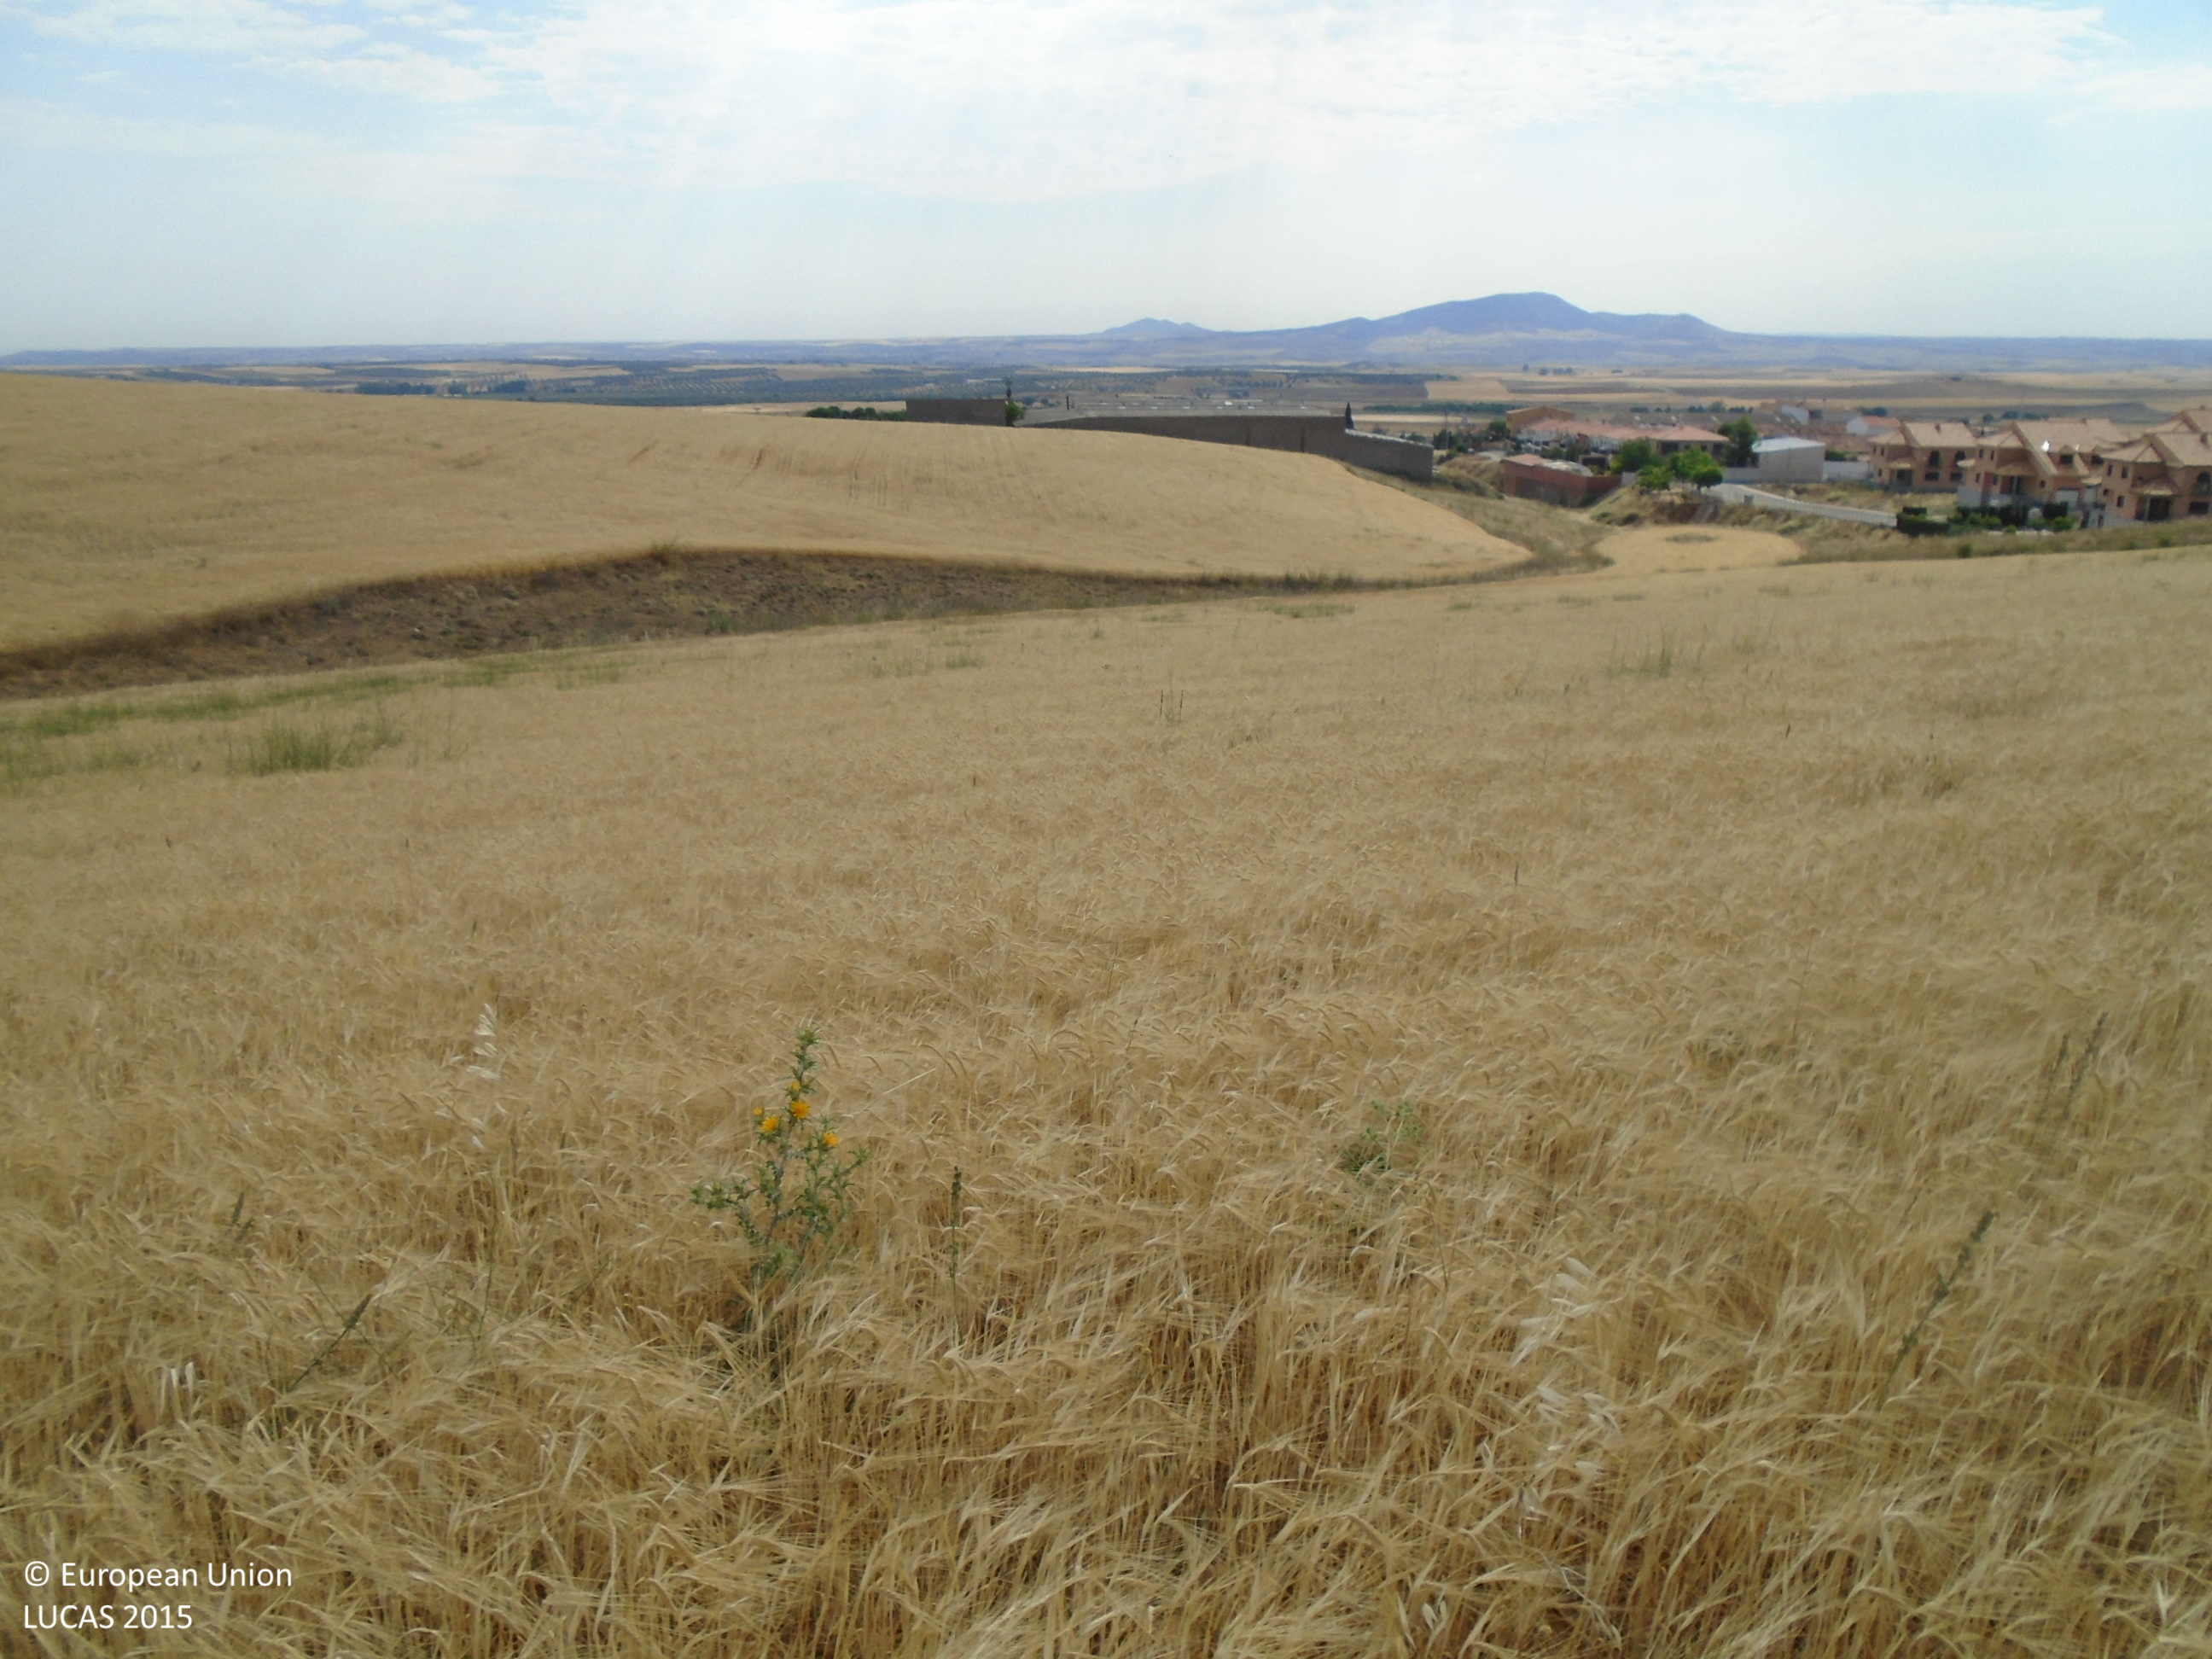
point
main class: Cropland
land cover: Barley
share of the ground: > 75 %
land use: Agriculture (excluding fallow land and kitchen gardens)
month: June
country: ES
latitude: 39.7436
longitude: -4.1904
